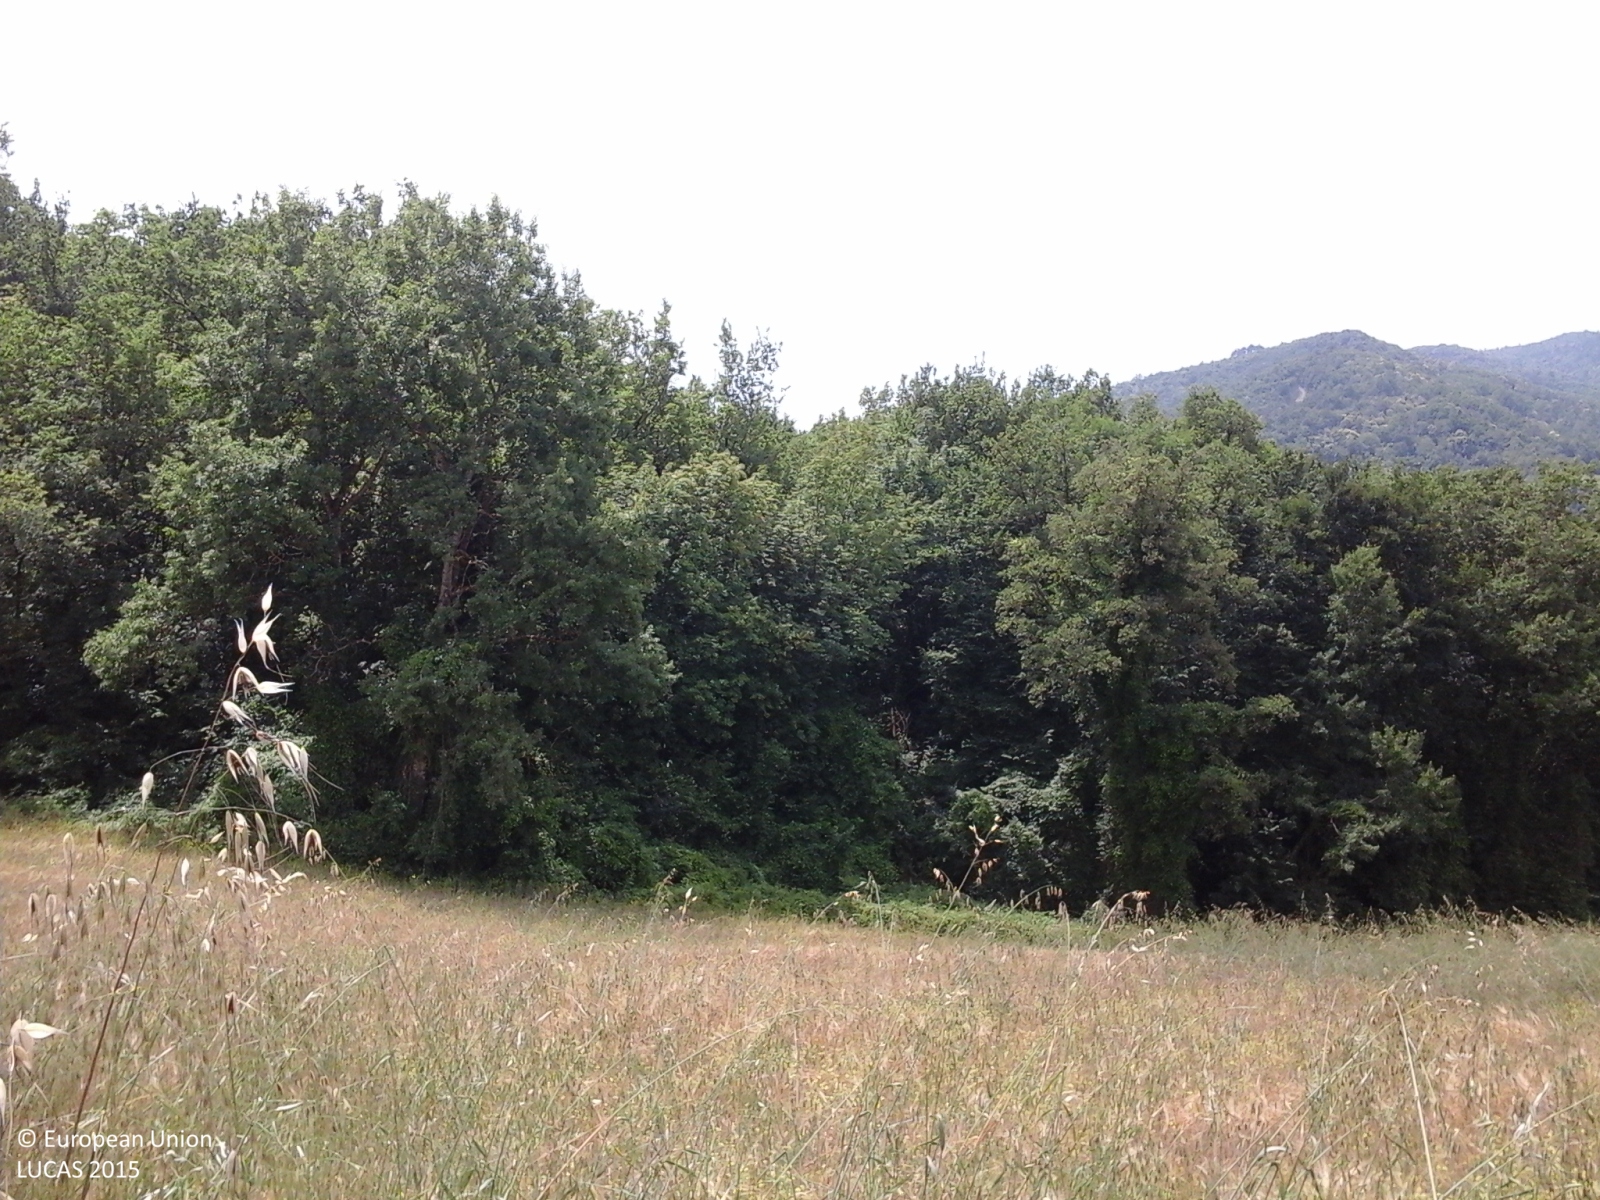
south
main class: Cropland
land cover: Barley
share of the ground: > 75 %
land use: Agriculture (excluding fallow land and kitchen gardens)
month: June
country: IT
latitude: 44.8189
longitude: 9.6845
